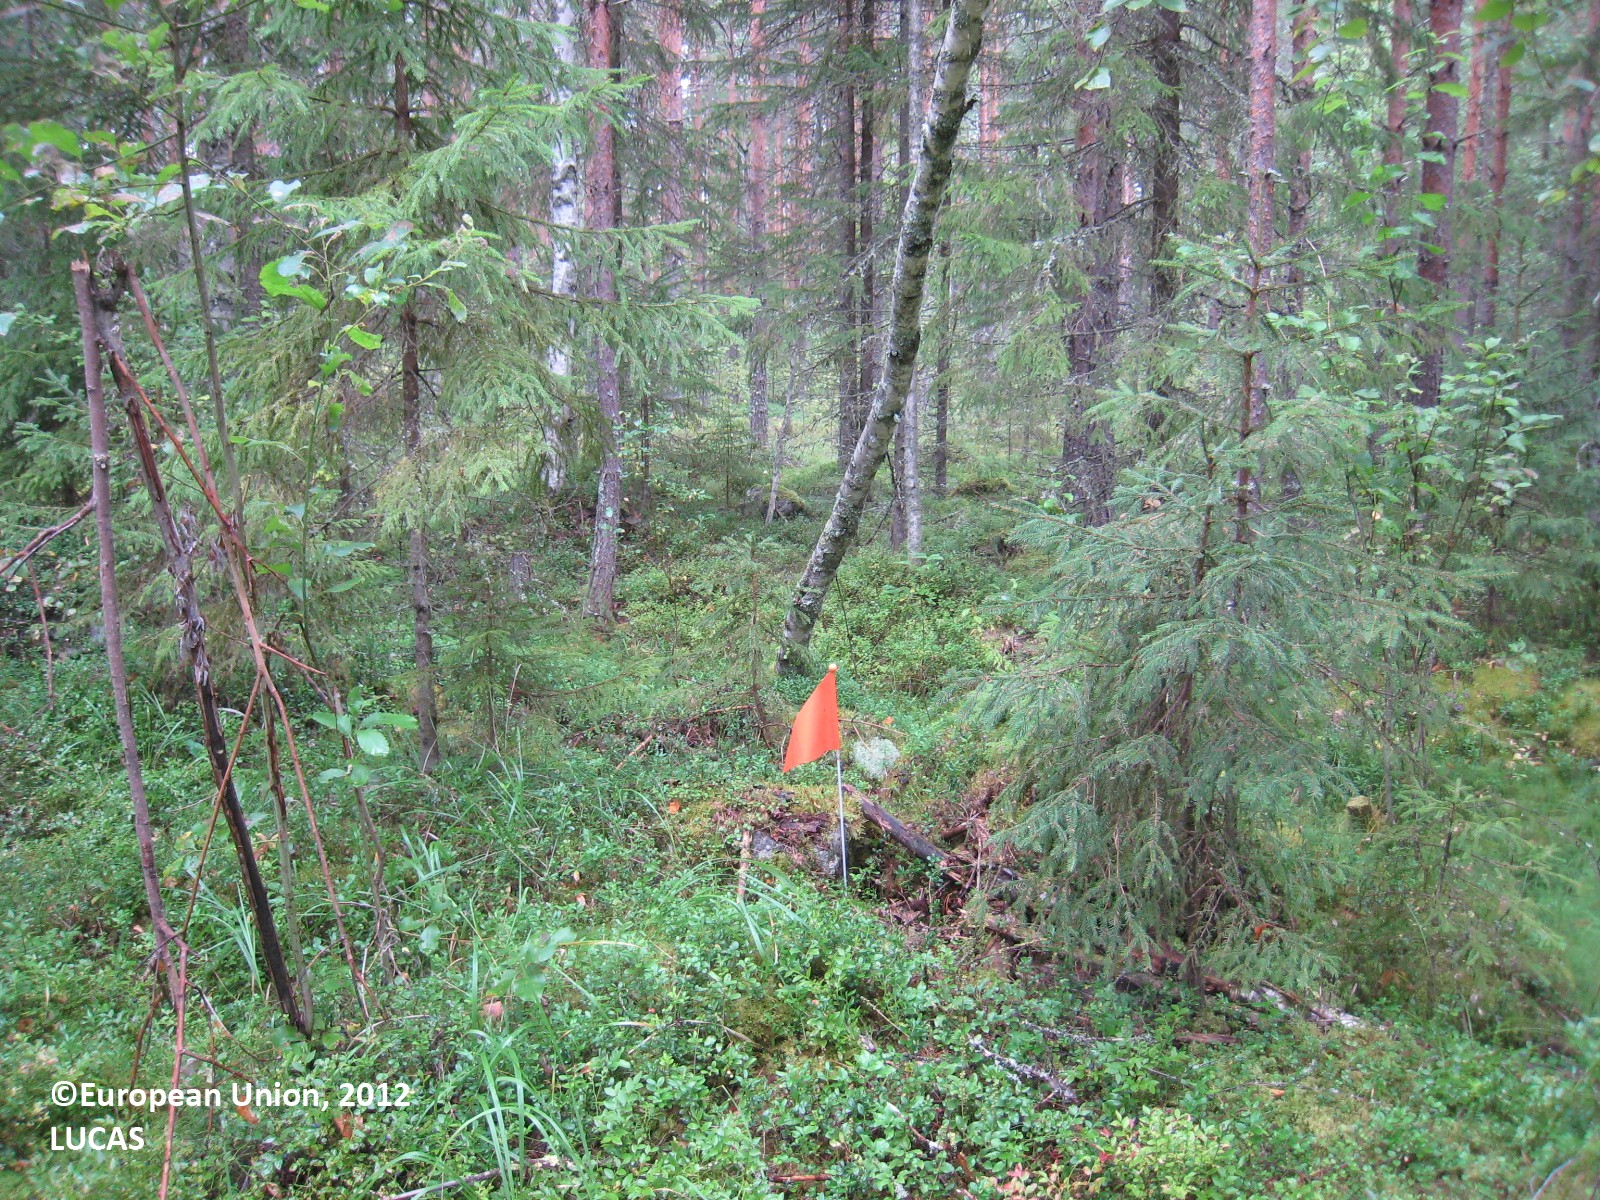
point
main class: Woodland
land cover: Other mixed woodland
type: boreal forest
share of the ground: 50 - 75 %
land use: Forestry
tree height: > 5 m
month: August
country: FI
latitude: 61.8559
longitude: 26.1941
